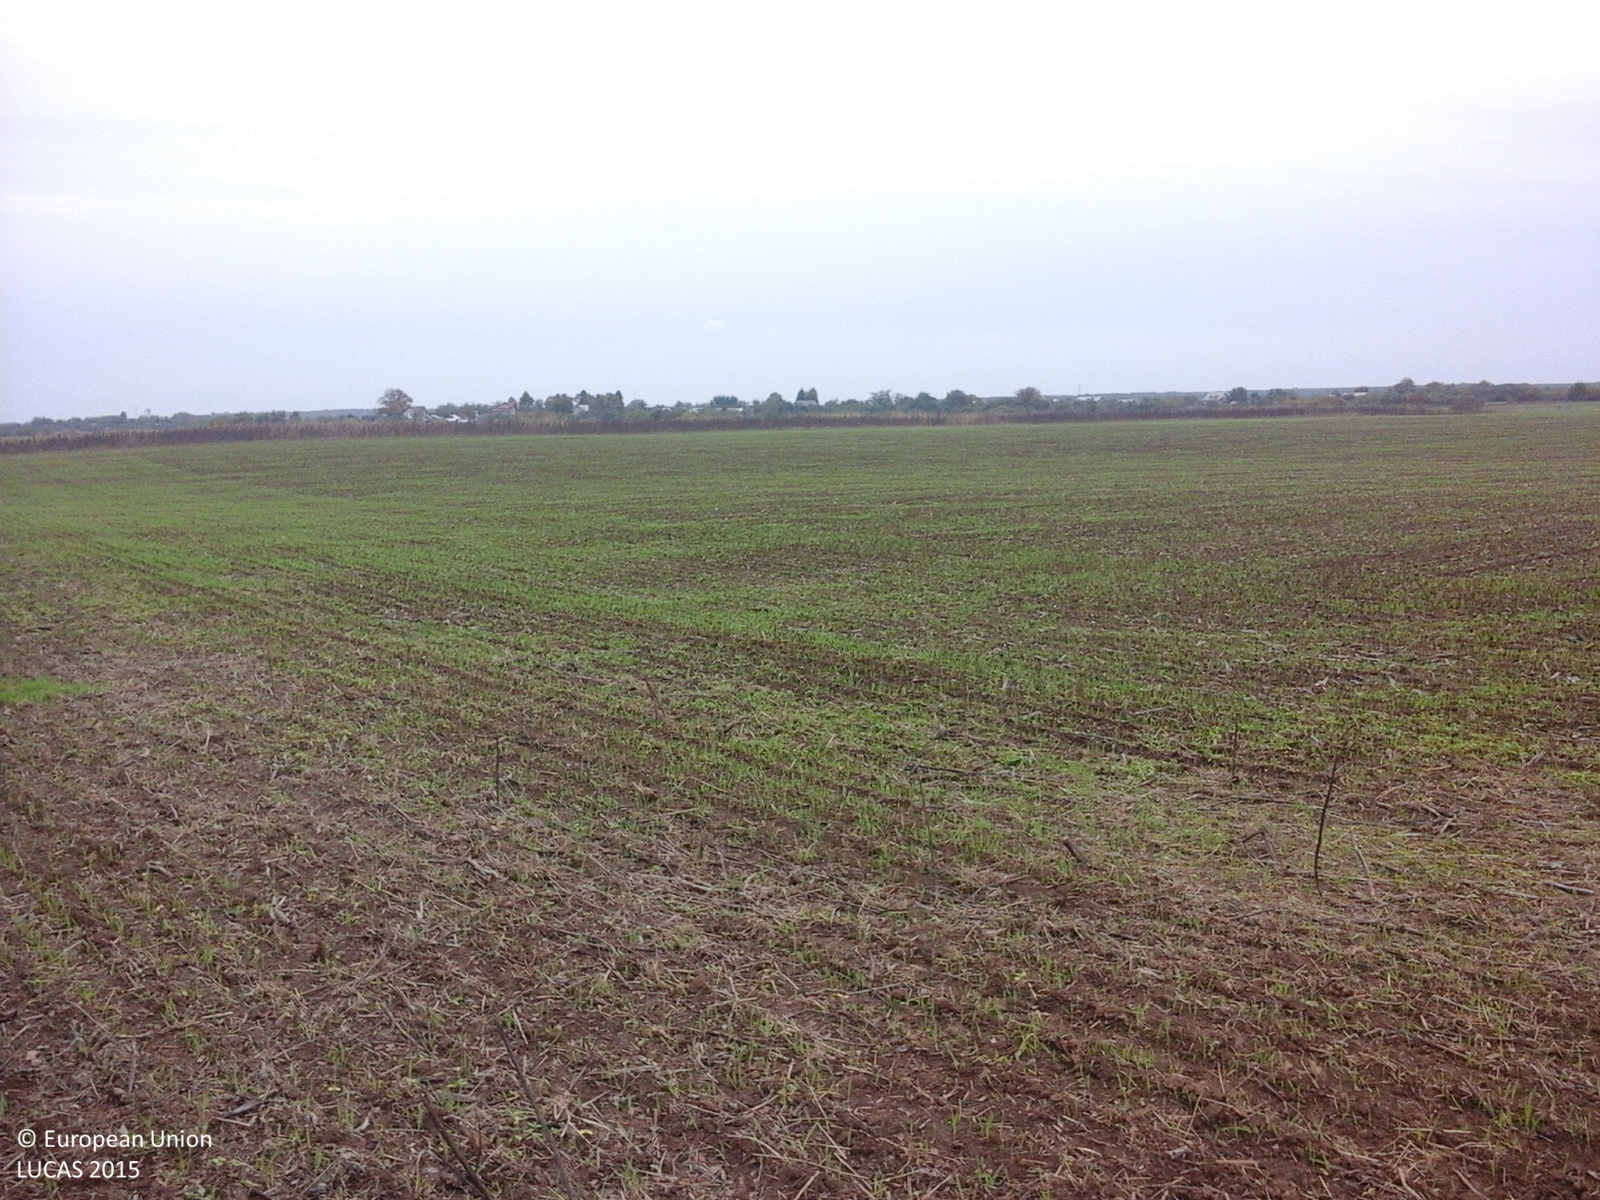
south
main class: Cropland
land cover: Common wheat
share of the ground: < 10 %
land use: Agriculture (excluding fallow land and kitchen gardens)
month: October
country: RO
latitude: 44.7600
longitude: 26.0632
